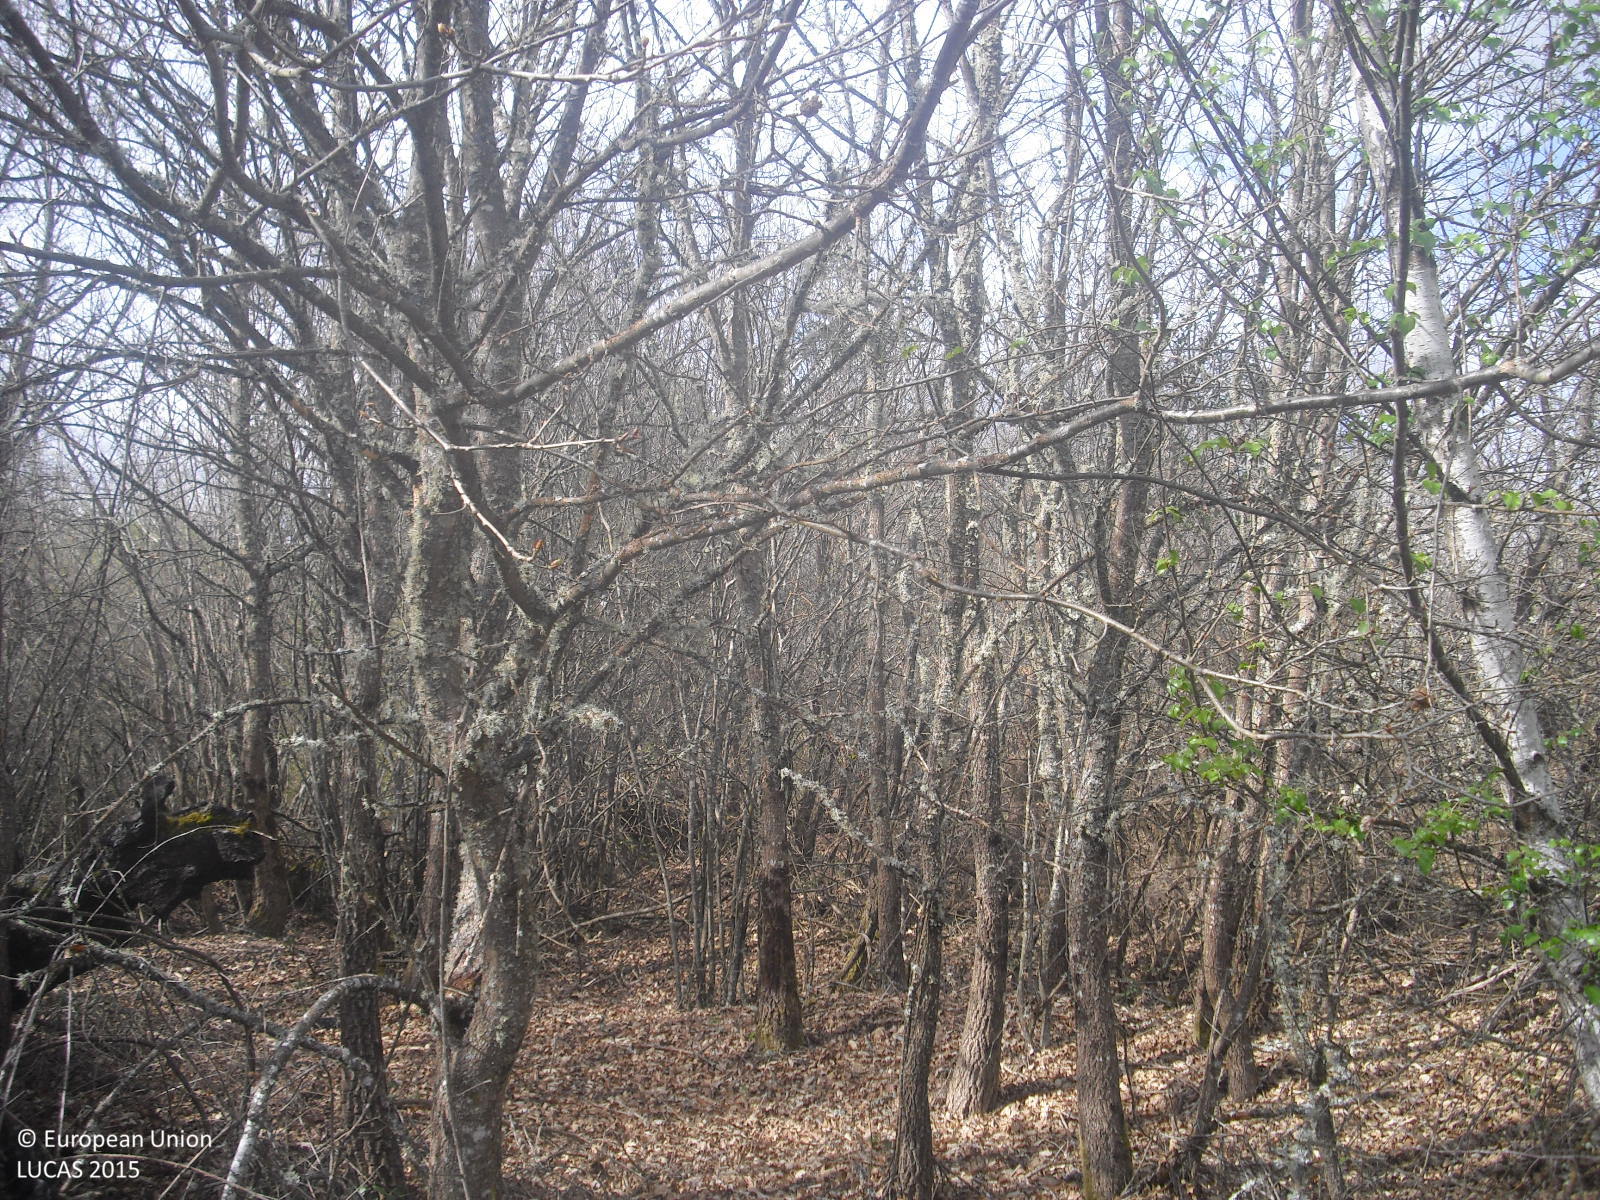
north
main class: Woodland
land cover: Broadleaved woodland
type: acidophilous oak and oak-birch forest
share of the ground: 50 - 75 %
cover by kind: broadleaved forest trees 70 %, shrubs 30 %
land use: Semi-natural and natural areas not in use
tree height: > 5 m
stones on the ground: < 10 %
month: April
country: ES
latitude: 42.0678
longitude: -7.8510
